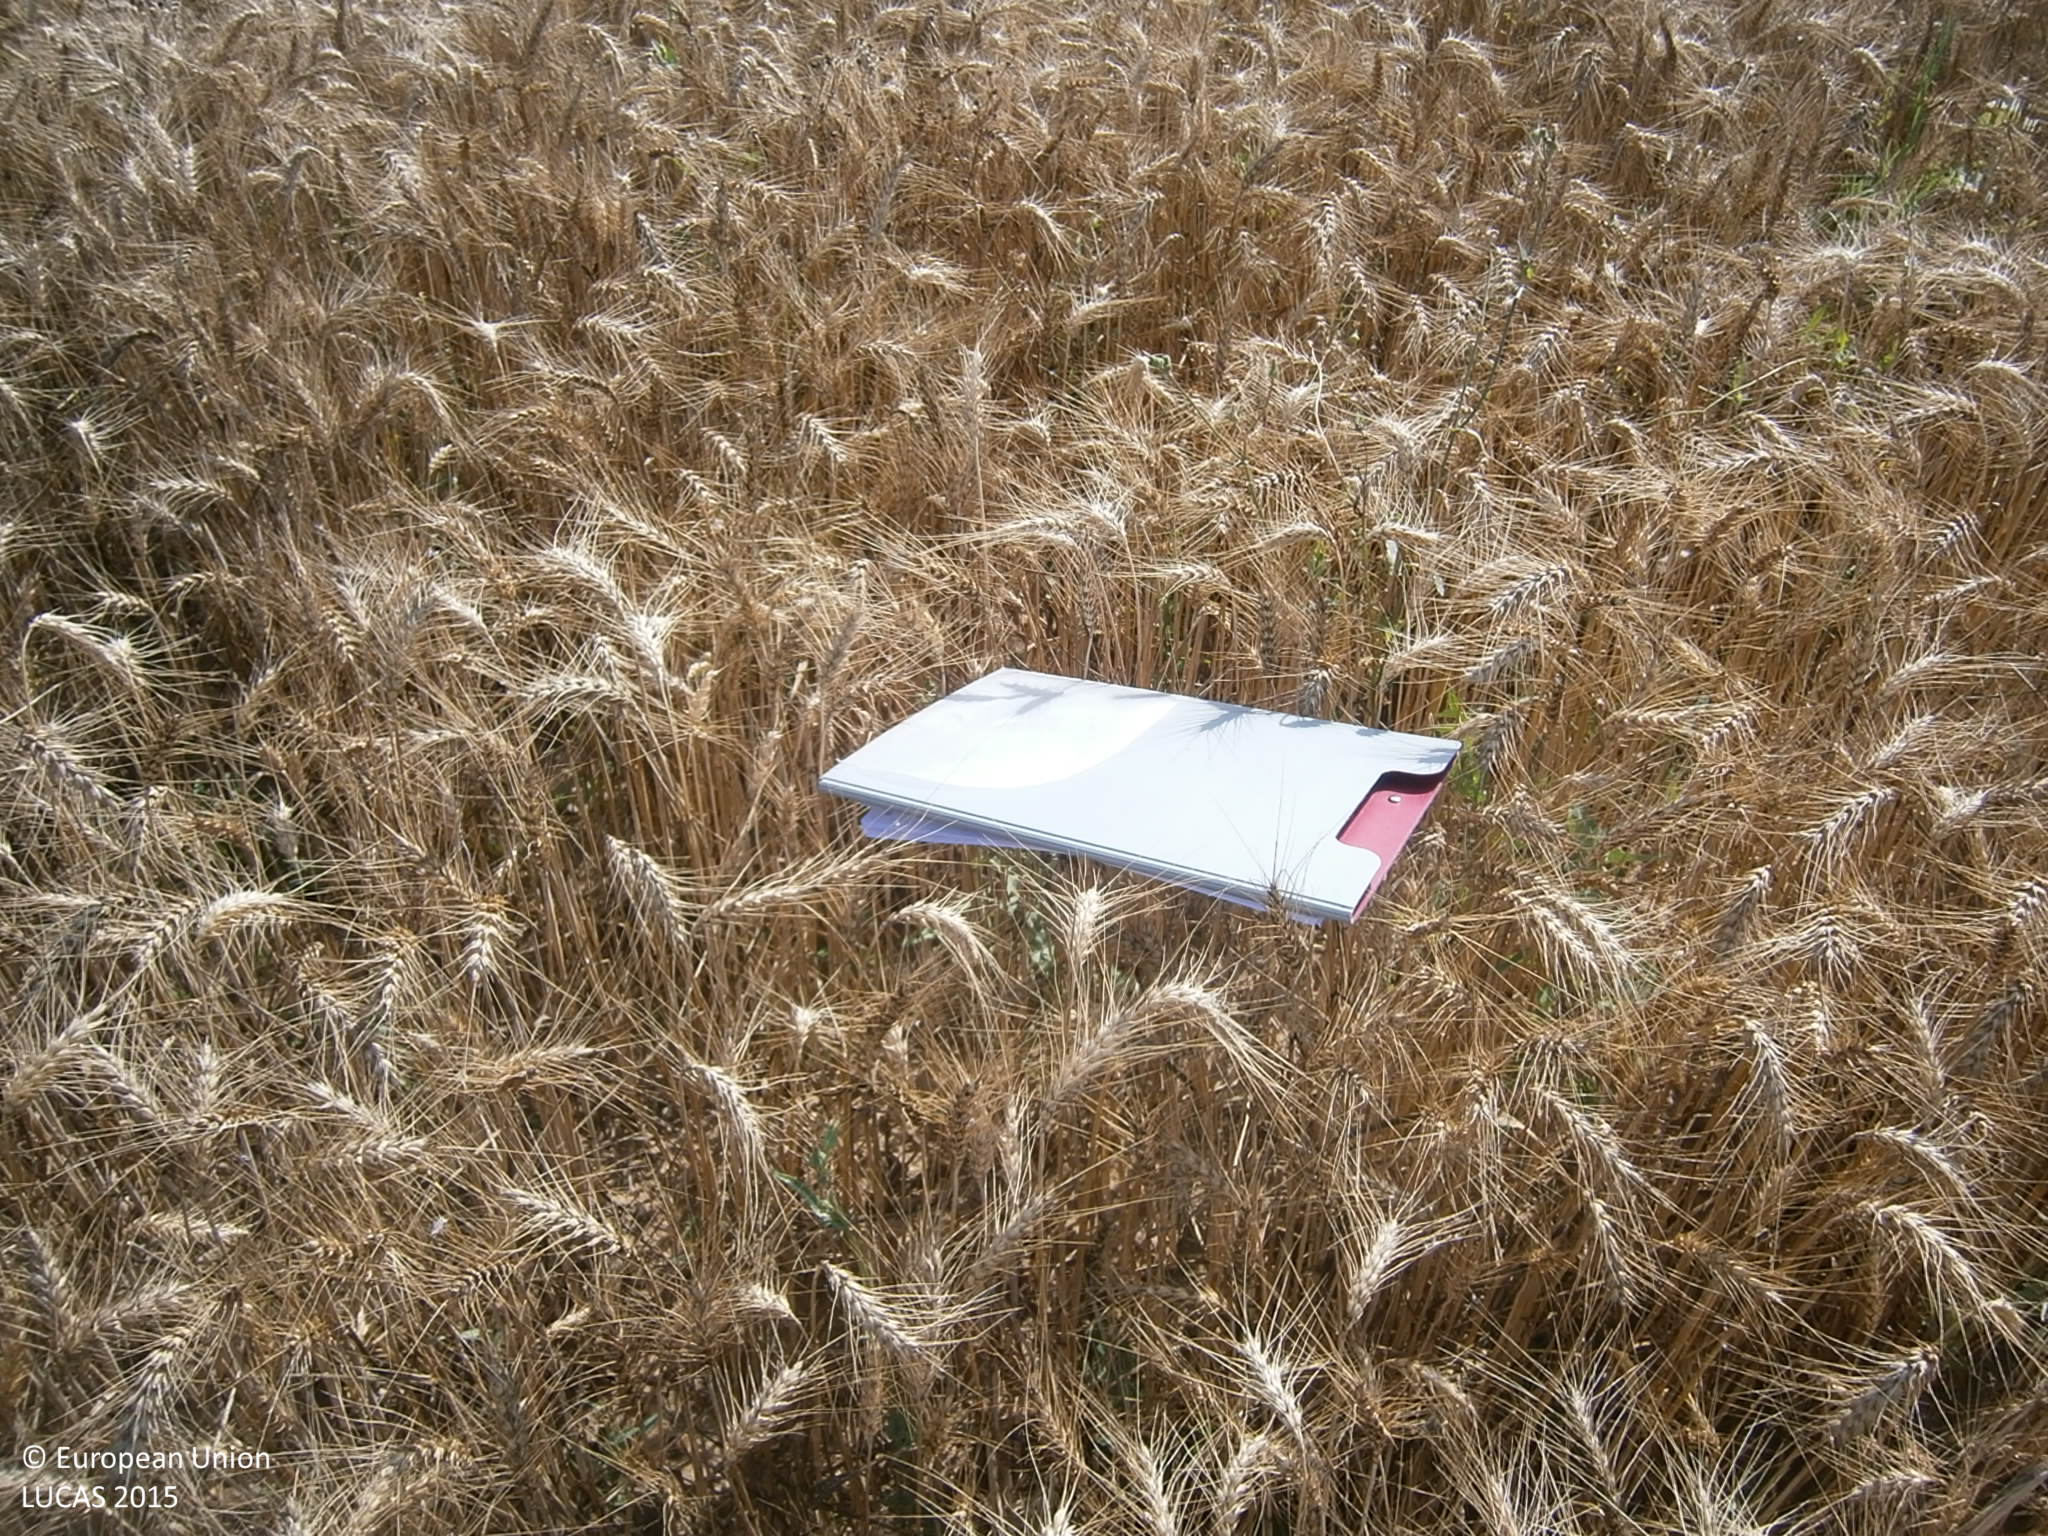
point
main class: Cropland
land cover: Durum wheat
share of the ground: > 75 %
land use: Agriculture (excluding fallow land and kitchen gardens)
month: June
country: ES
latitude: 38.8724
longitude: -6.5313
